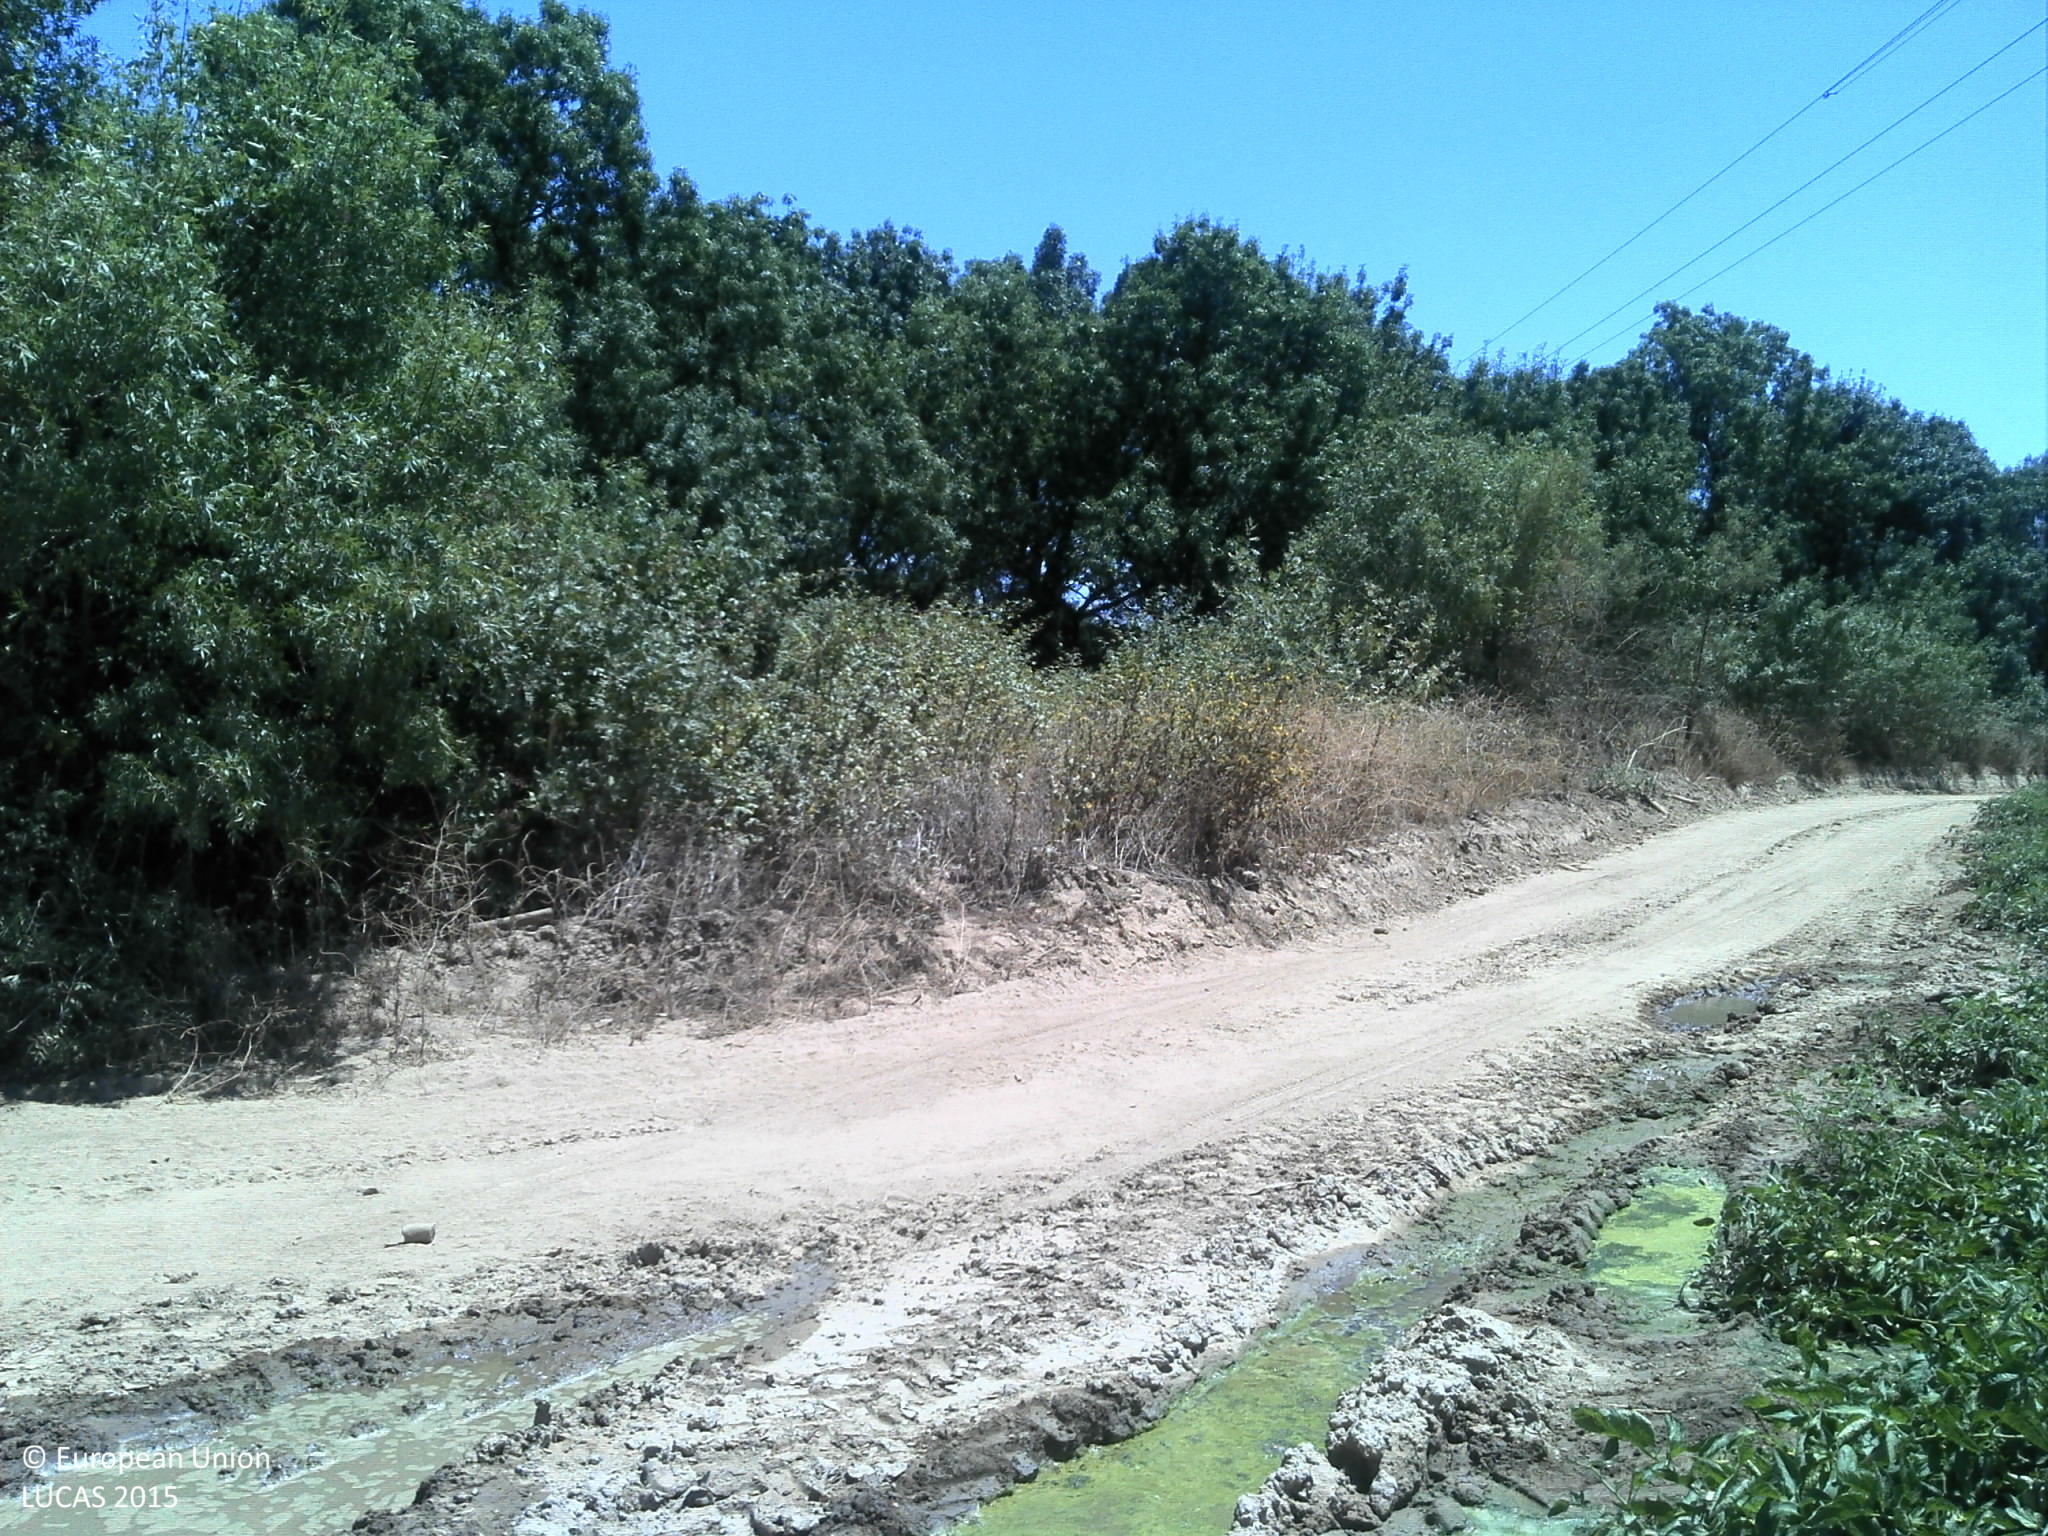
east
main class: Cropland
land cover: Tomatoes
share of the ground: > 75 %
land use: Agriculture (excluding fallow land and kitchen gardens)
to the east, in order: Tomatoes; Electric lines; Tomatoes; Tracks; Grassland with sparse tree/shrub cover; Shrubland with sparse tree cover
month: June
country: PT
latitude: 39.1959
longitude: -8.6786
